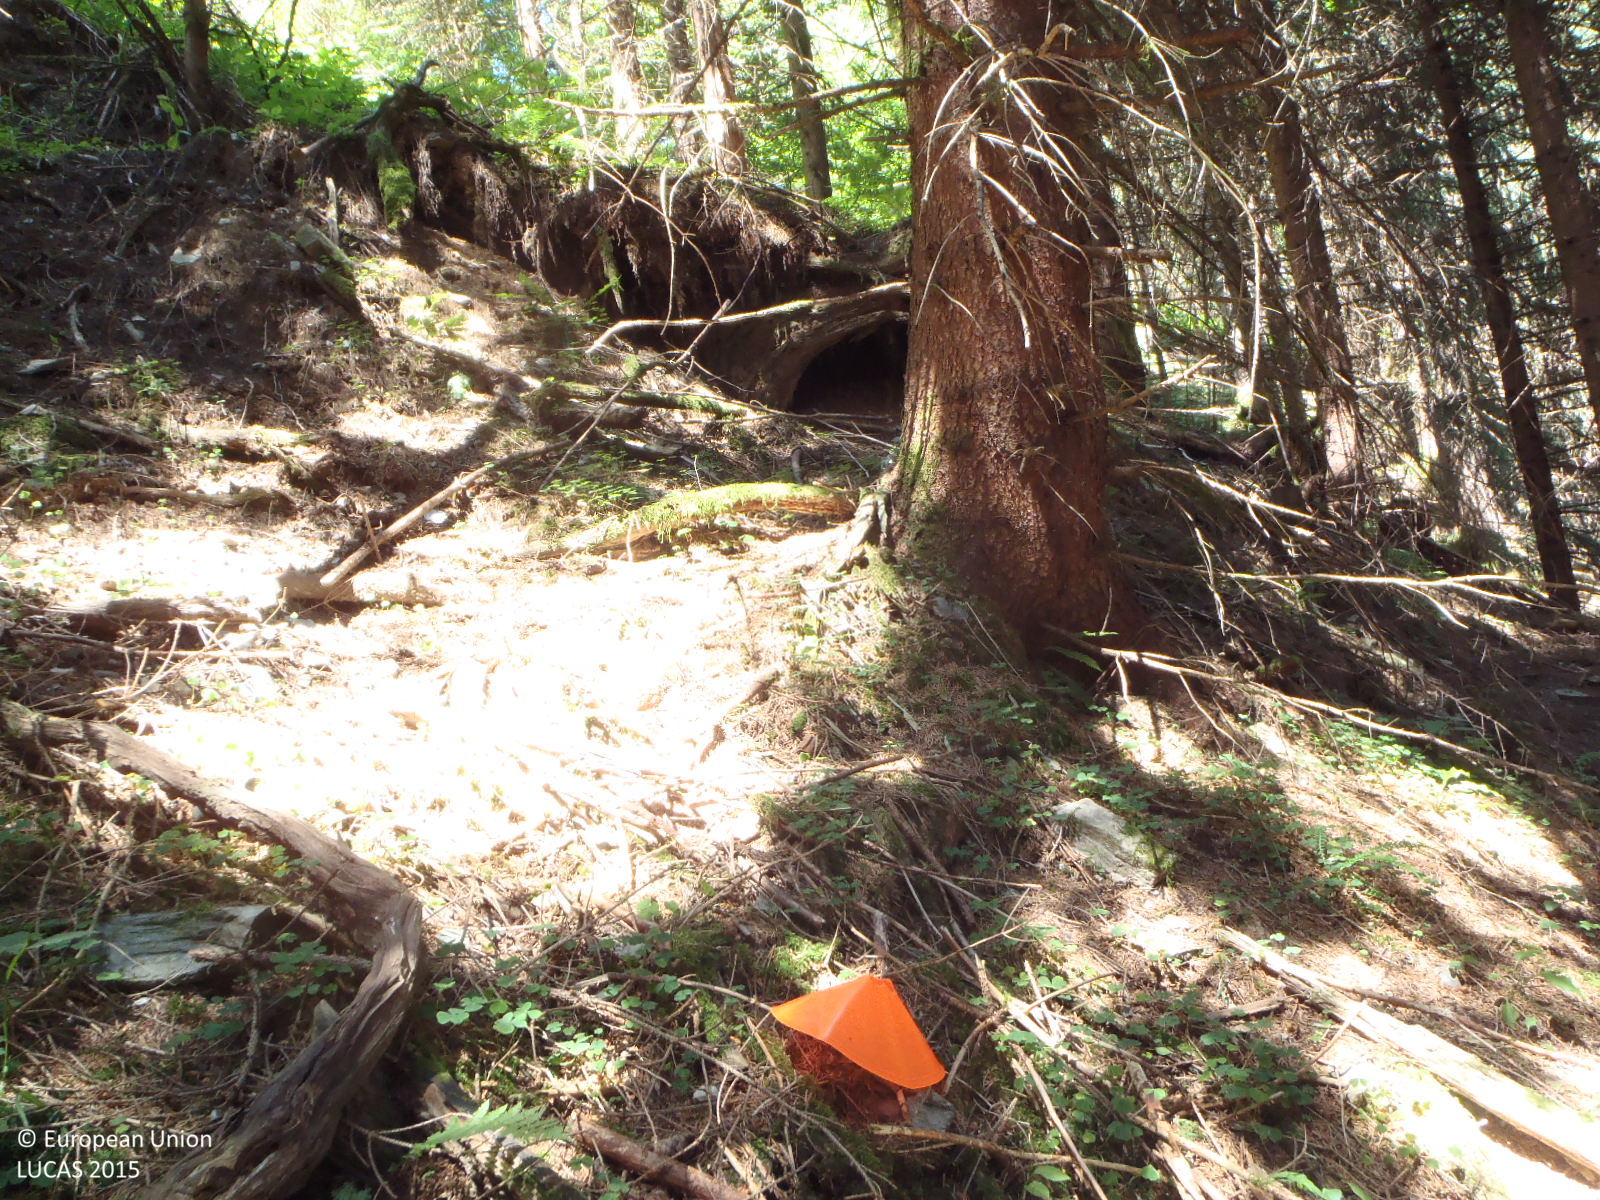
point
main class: Woodland
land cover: Spruce dominated coniferous woodland
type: alpine coniferous forest
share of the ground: > 75 %
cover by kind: coniferous forest trees 95 %, lichens and mosses 5 %
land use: Forestry
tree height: > 5 m
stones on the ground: < 10 %
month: July
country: AT
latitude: 47.3873
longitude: 12.3959
